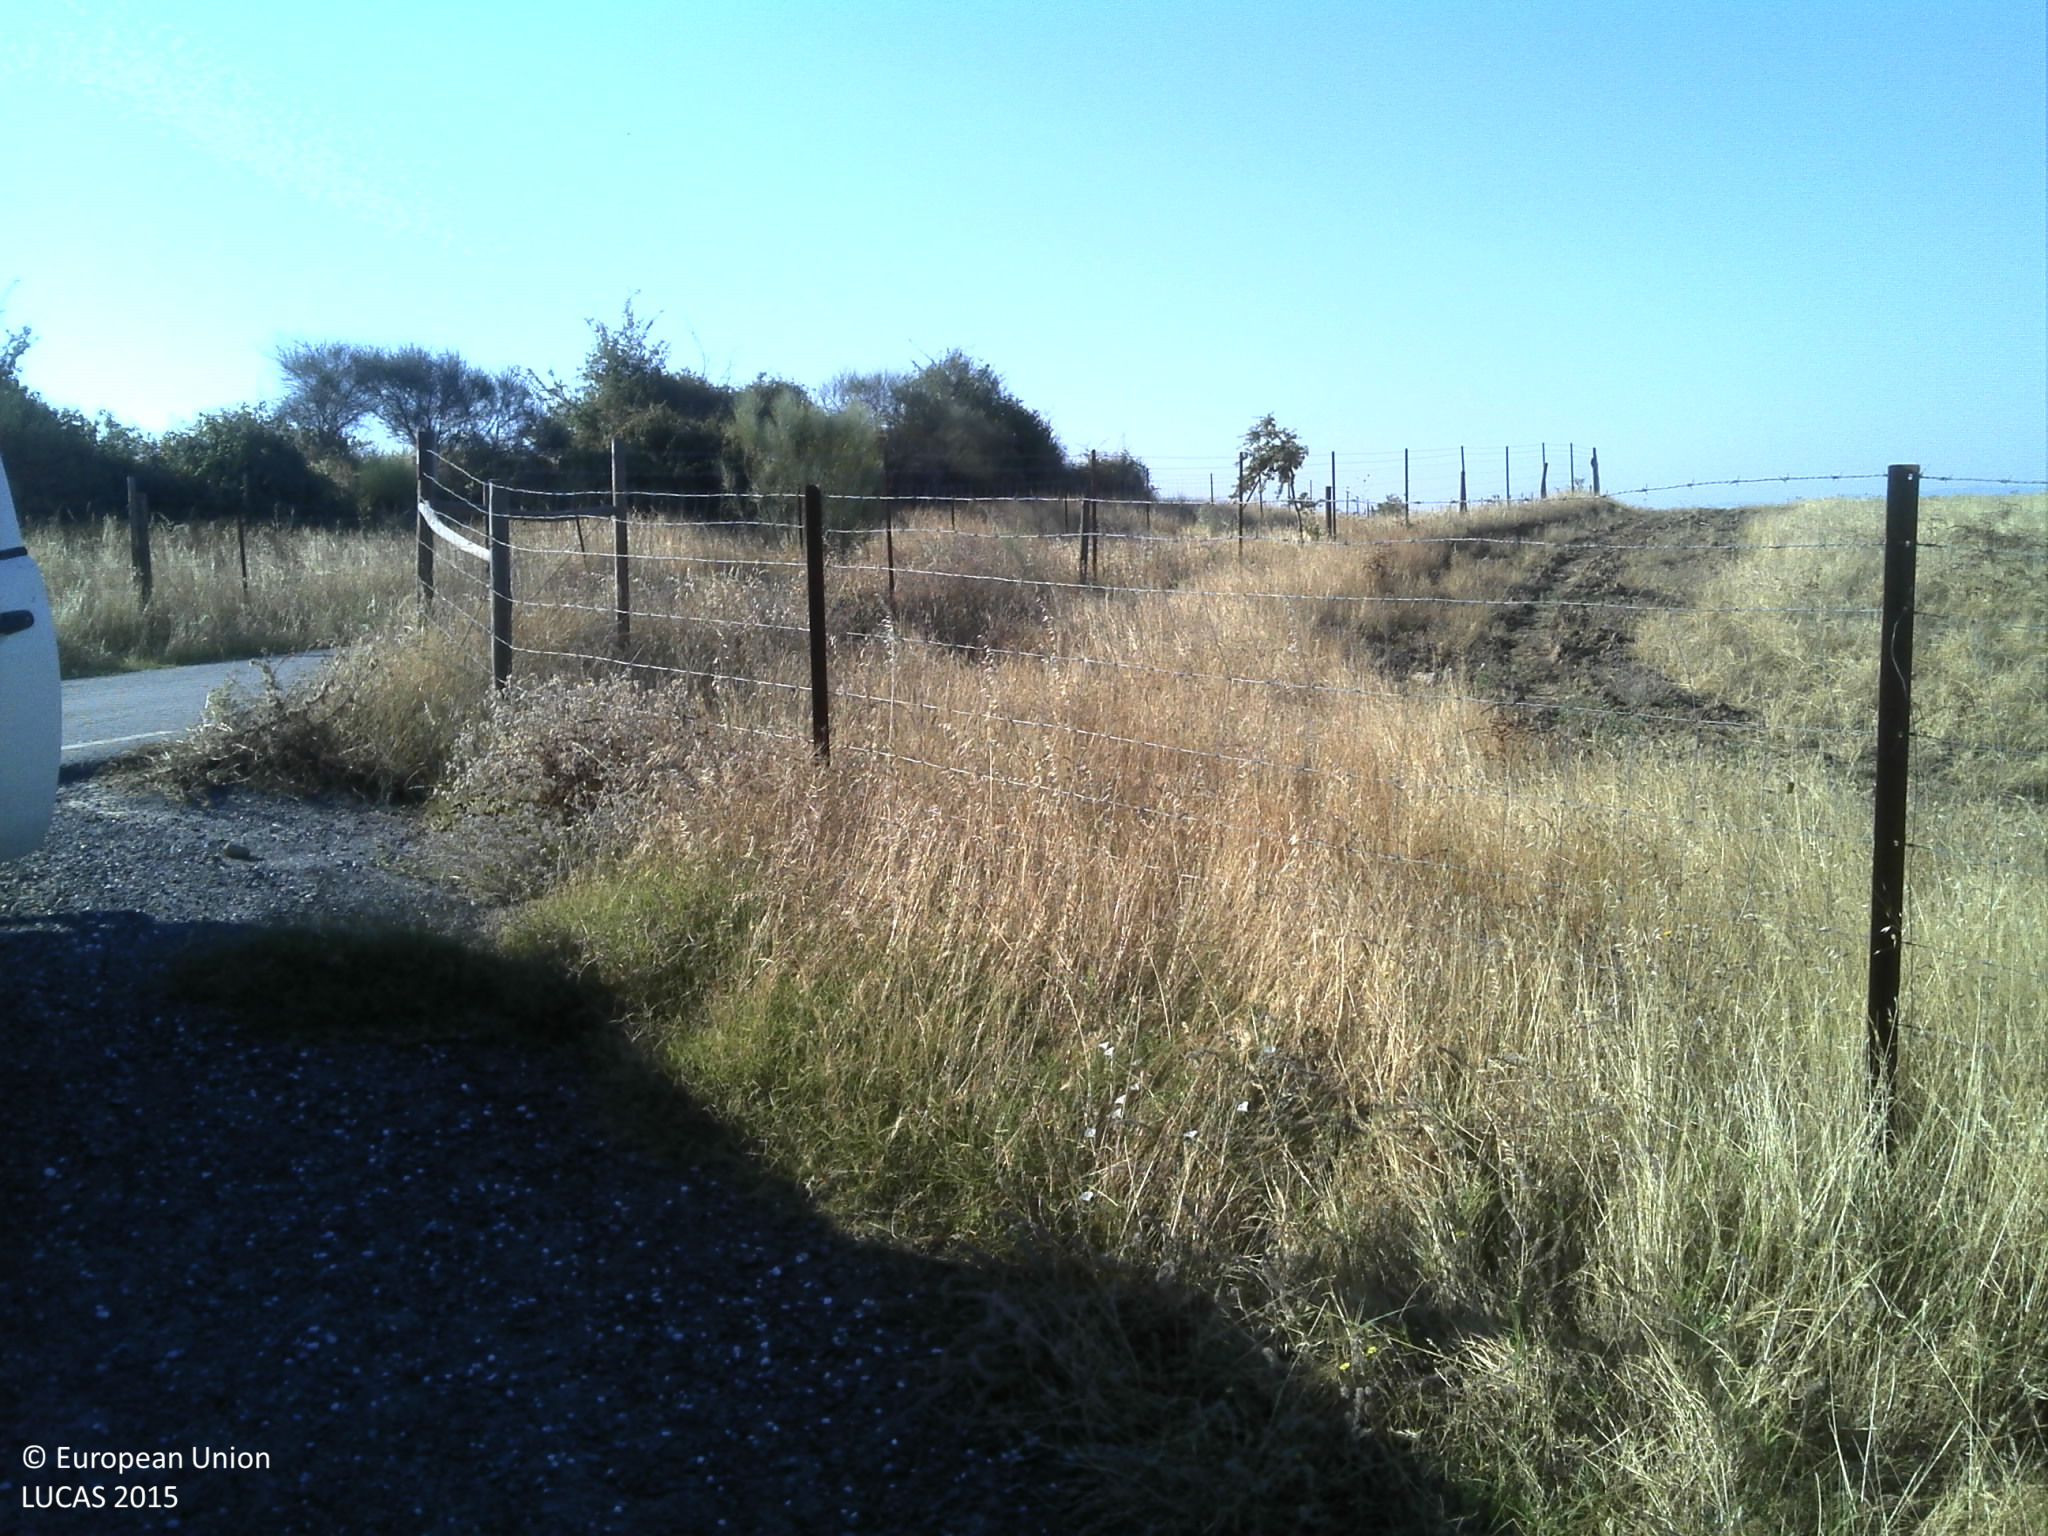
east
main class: Cropland
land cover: Arable land (only in case pi)
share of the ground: 50 - 75 %
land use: Agriculture (excluding fallow land and kitchen gardens)
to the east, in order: Arable land (only in case pi); Tracks; Arable land (only in case pi); Rivers and streams; Arable land (only in case pi); Rock outcrops; Arable land (only in case pi); Rock outcrops; Arable land (only in case pi)
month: June
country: PT
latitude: 39.9157
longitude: -7.3052
